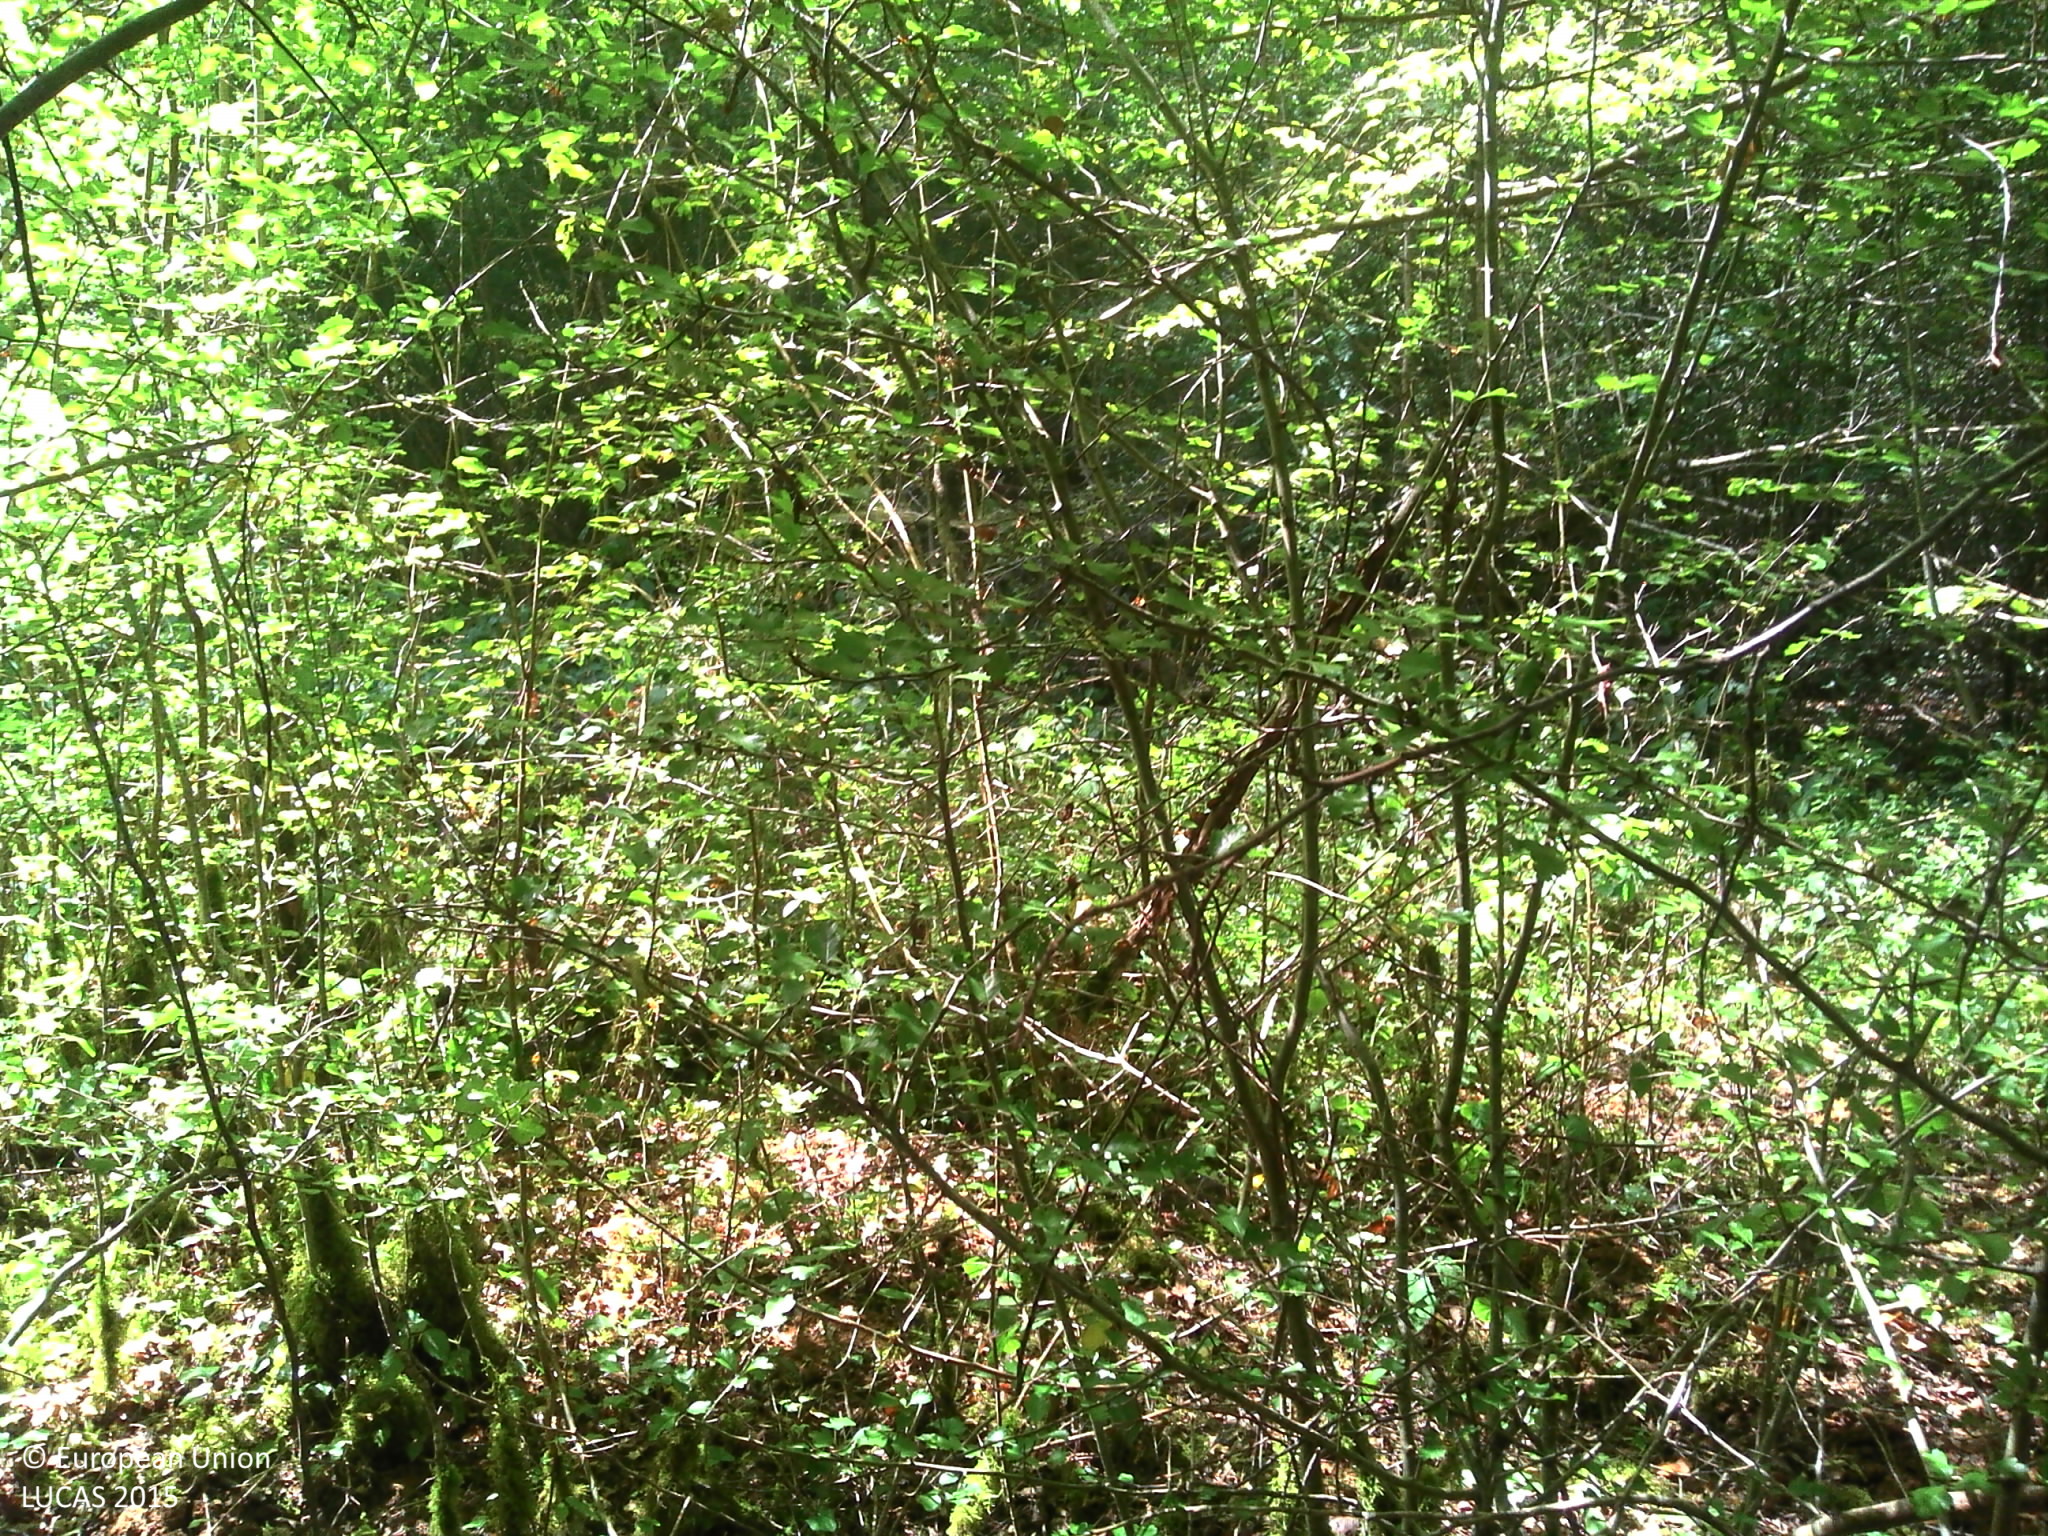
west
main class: Woodland
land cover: Broadleaved woodland
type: mesophytic deciduous forest
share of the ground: > 75 %
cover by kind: broadleaved forest trees 85 %, lichens and mosses 10 %, herbaceous plants 5 %
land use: Forestry
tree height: > 5 m
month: July
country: FR
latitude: 48.0725
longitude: 4.9660
